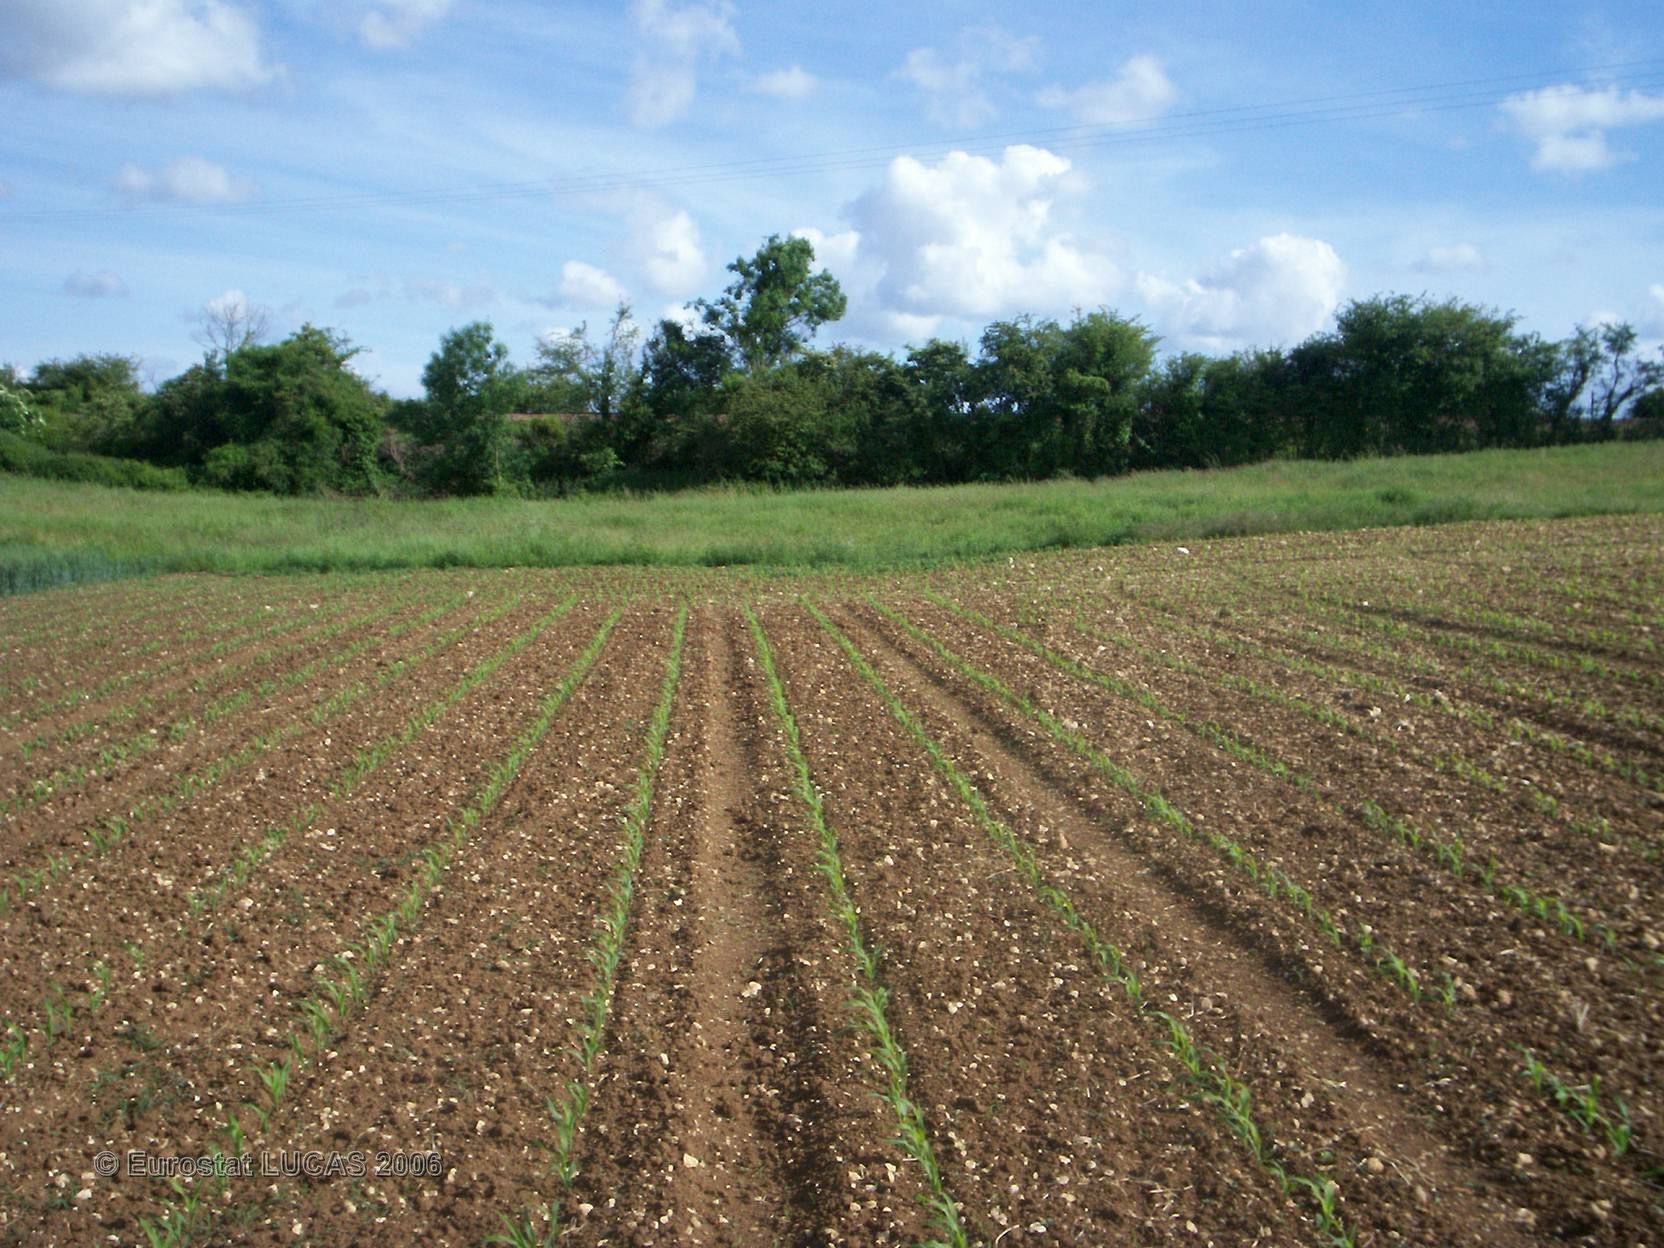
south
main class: Cropland
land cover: Maize
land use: Agriculture (excluding fallow land and kitchen gardens)
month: May
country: FR
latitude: 45.6963
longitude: -0.7744
